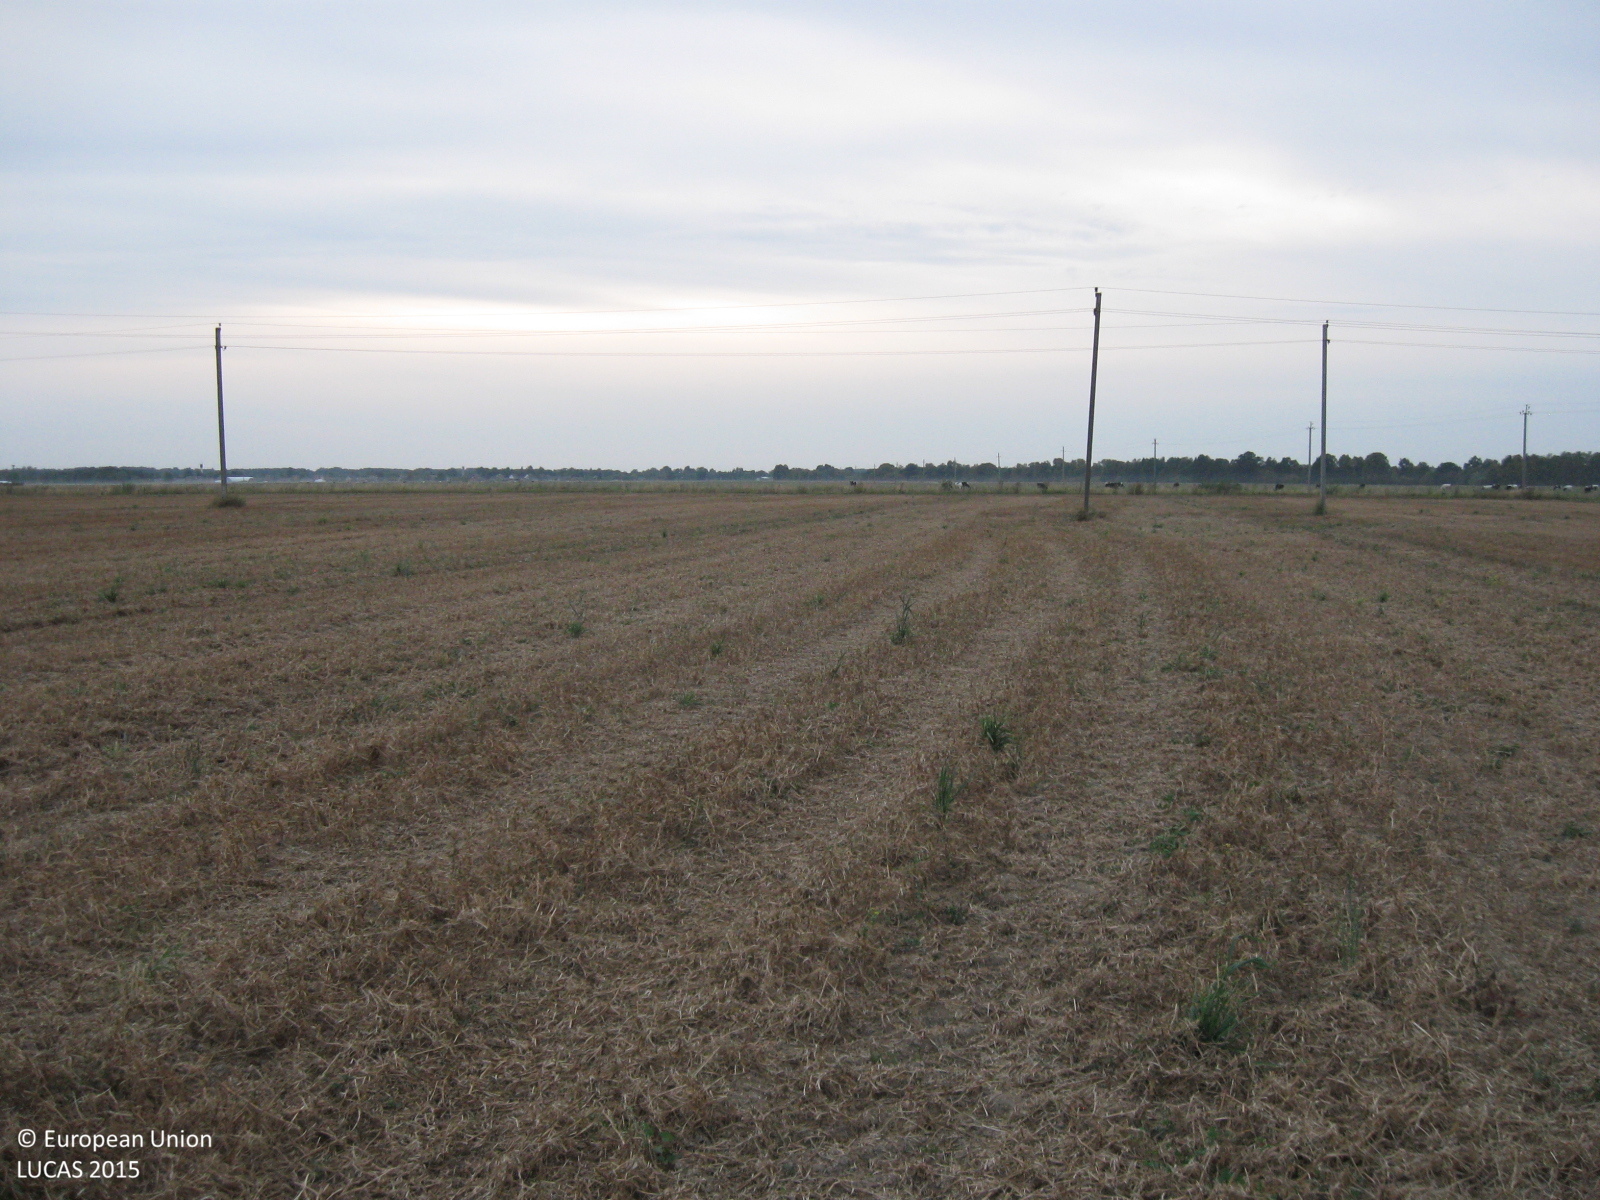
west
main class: Cropland
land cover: Dry pulses
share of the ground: 10 - 25 %
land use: Agriculture (excluding fallow land and kitchen gardens)
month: August
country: LT
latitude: 55.1816
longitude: 23.1230
